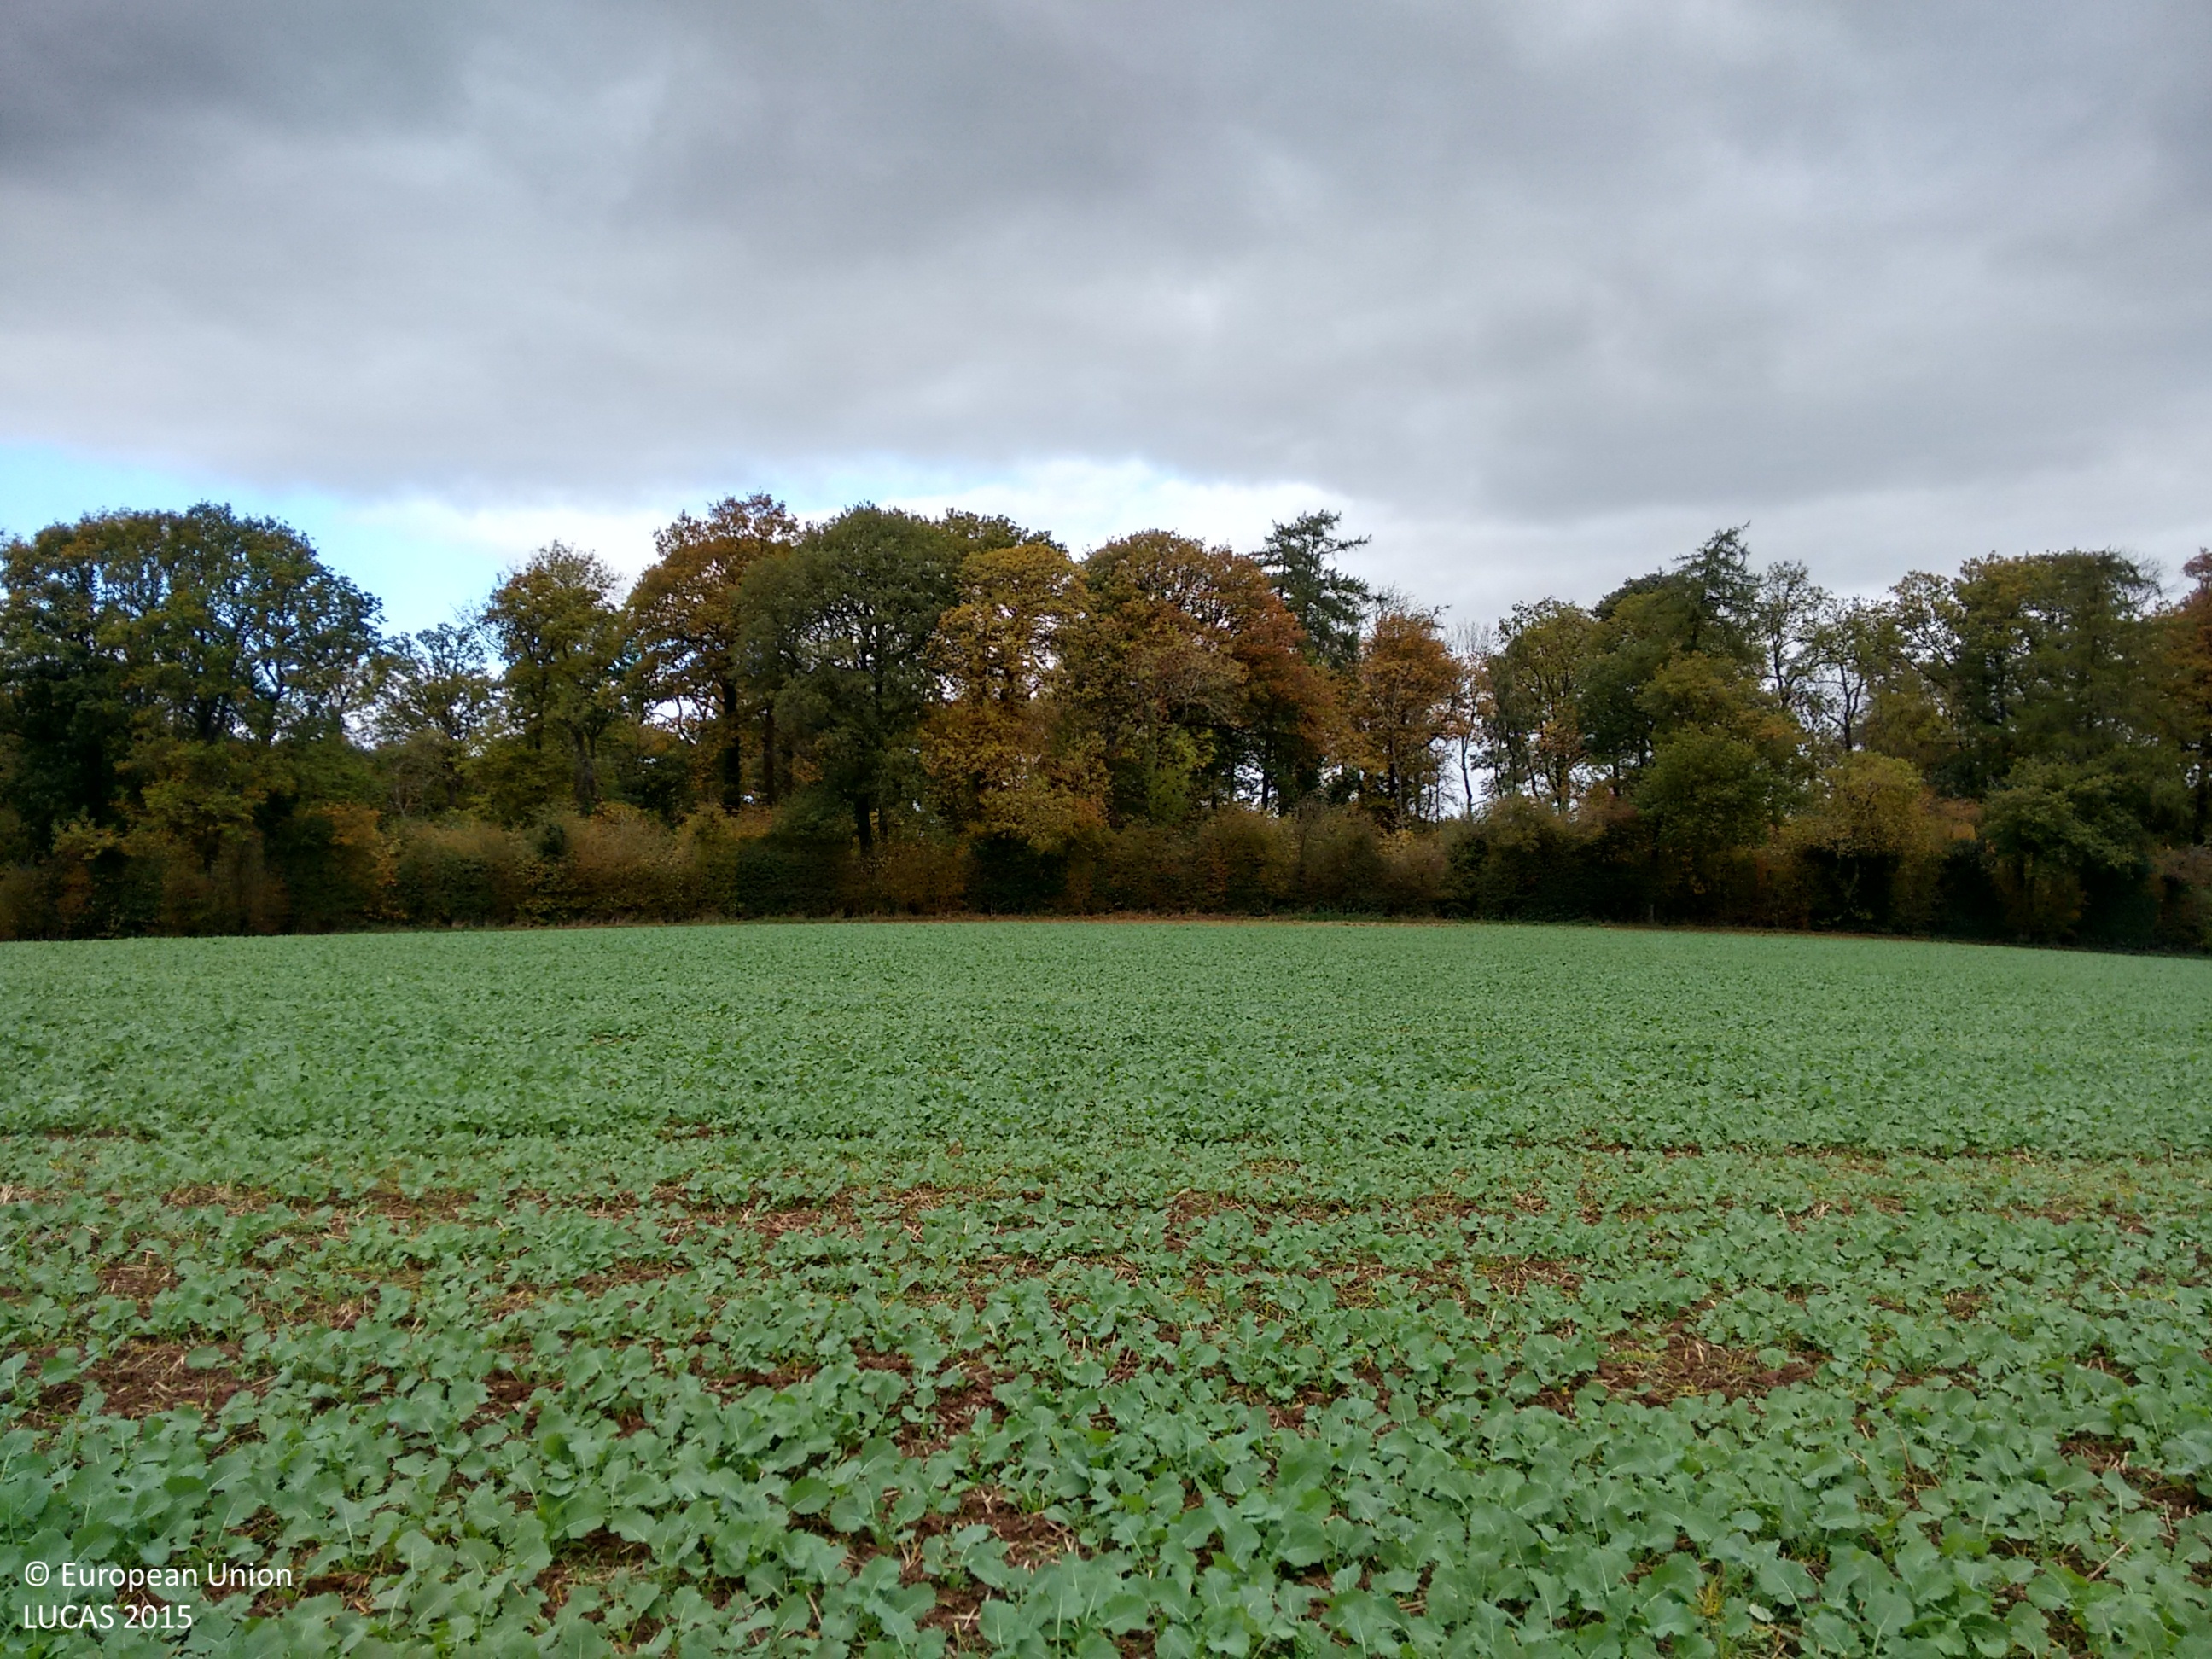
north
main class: Cropland
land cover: Rape and turnip rape
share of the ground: > 75 %
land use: Agriculture (excluding fallow land and kitchen gardens)
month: October
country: GB
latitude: 51.9839
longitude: -2.6937
